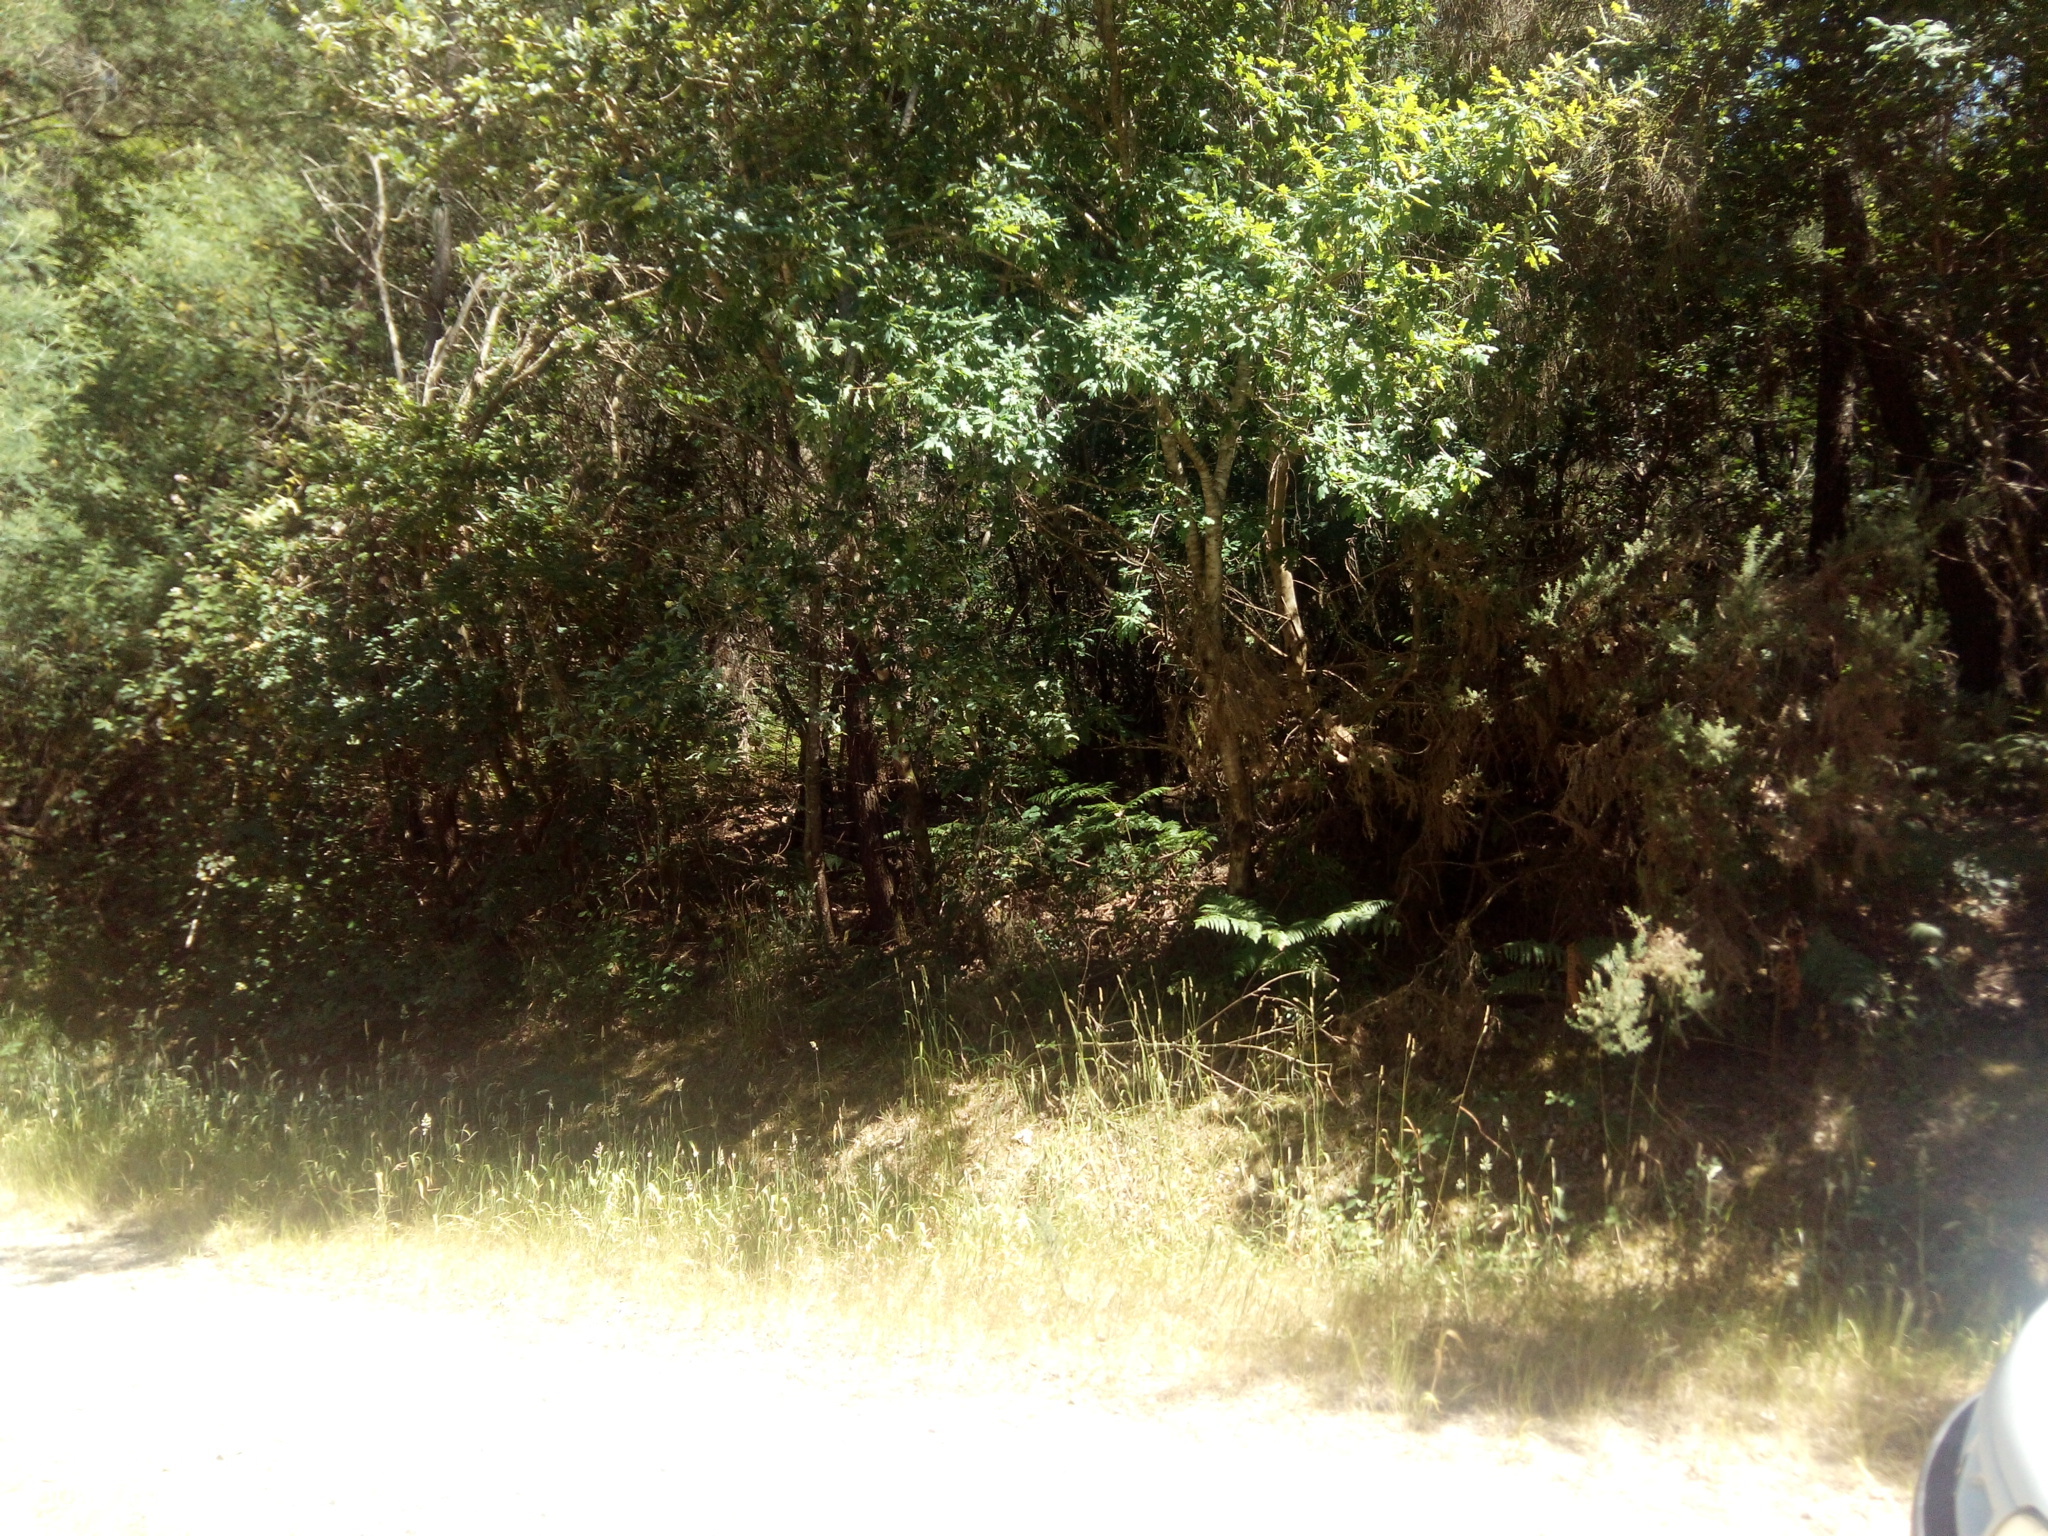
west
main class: Woodland
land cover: Pine dominated mixed woodland
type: hemiboreal forest and nemoral coniferous forest and mixed broadleaved-coniferous forest
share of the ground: > 75 %
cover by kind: coniferous forest trees 75 %, broadleaved forest trees 25 %
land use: Forestry
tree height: > 5 m
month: June
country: ES
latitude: 42.7586
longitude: -8.4154
